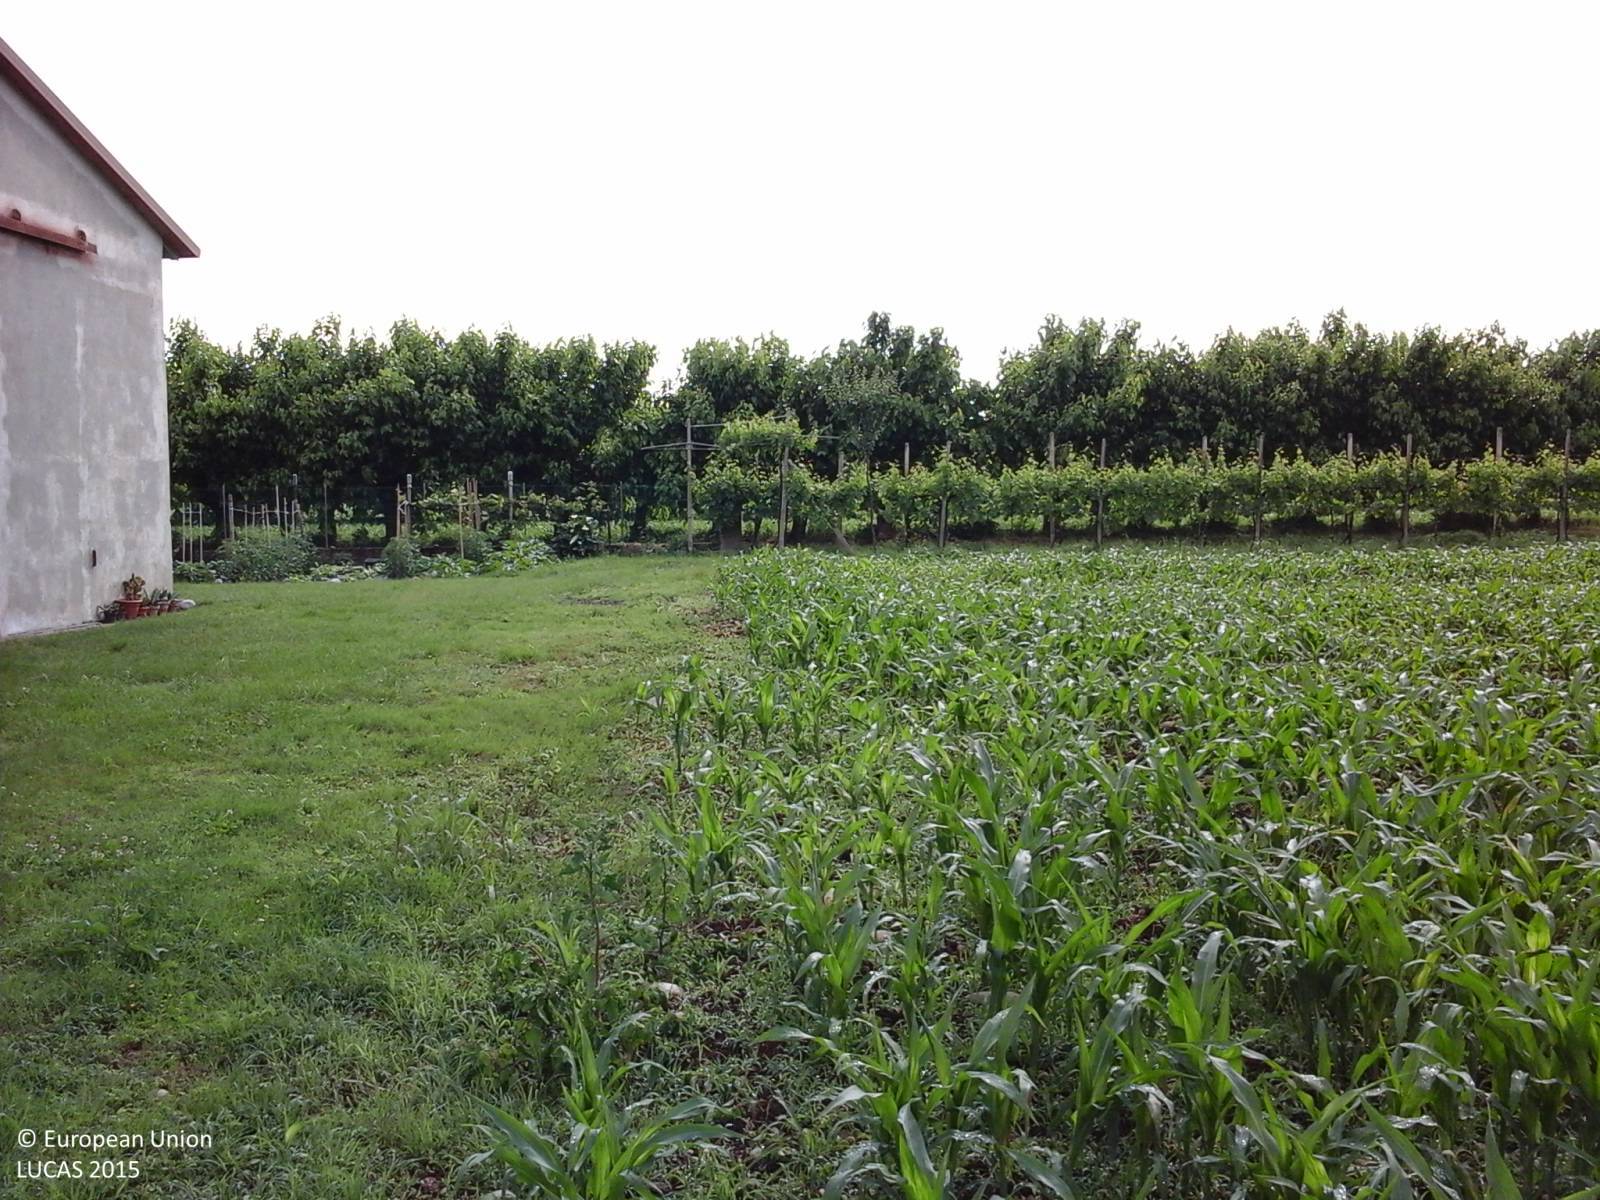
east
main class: Cropland
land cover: Barley
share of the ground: > 75 %
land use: Agriculture (excluding fallow land and kitchen gardens)
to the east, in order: Barley; Fences; Lines of trees; Artificial constructions in urban areas; Grassland without tree/shrub cover; Other fresh vegetables; Fences; Grass margins; Tracks; Grass margins; Lines of trees; Maize; Lines of trees; Maize; Electric lines; Maize; Other non-permanent industrial crops; Grass margins; Tracks; Grass margins; Vineyards; Grassland without tree/shrub cover; Olive groves; Temporary grasslands
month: May
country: IT
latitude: 46.0198
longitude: 13.0320
